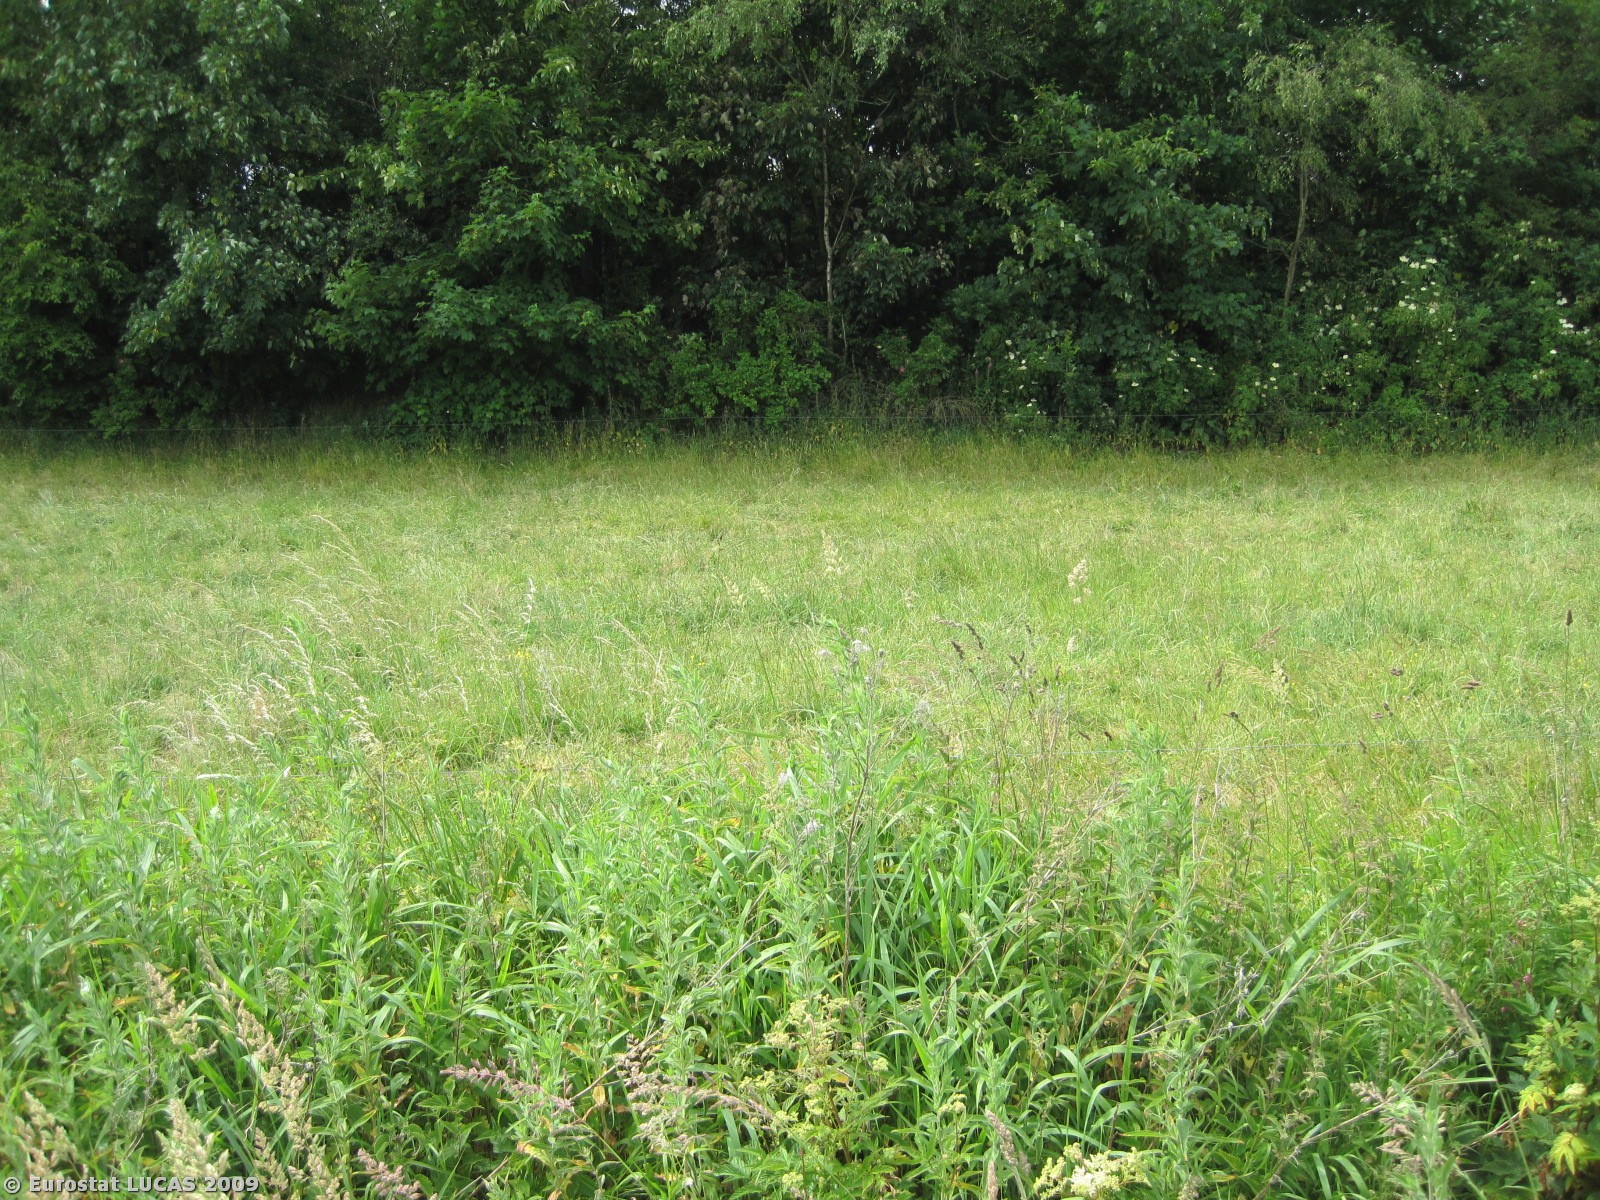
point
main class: Grassland
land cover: Grassland without tree/shrub cover
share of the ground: > 75 %
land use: Agriculture (excluding fallow land and kitchen gardens)
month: June
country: DK
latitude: 56.5017
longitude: 8.4261
